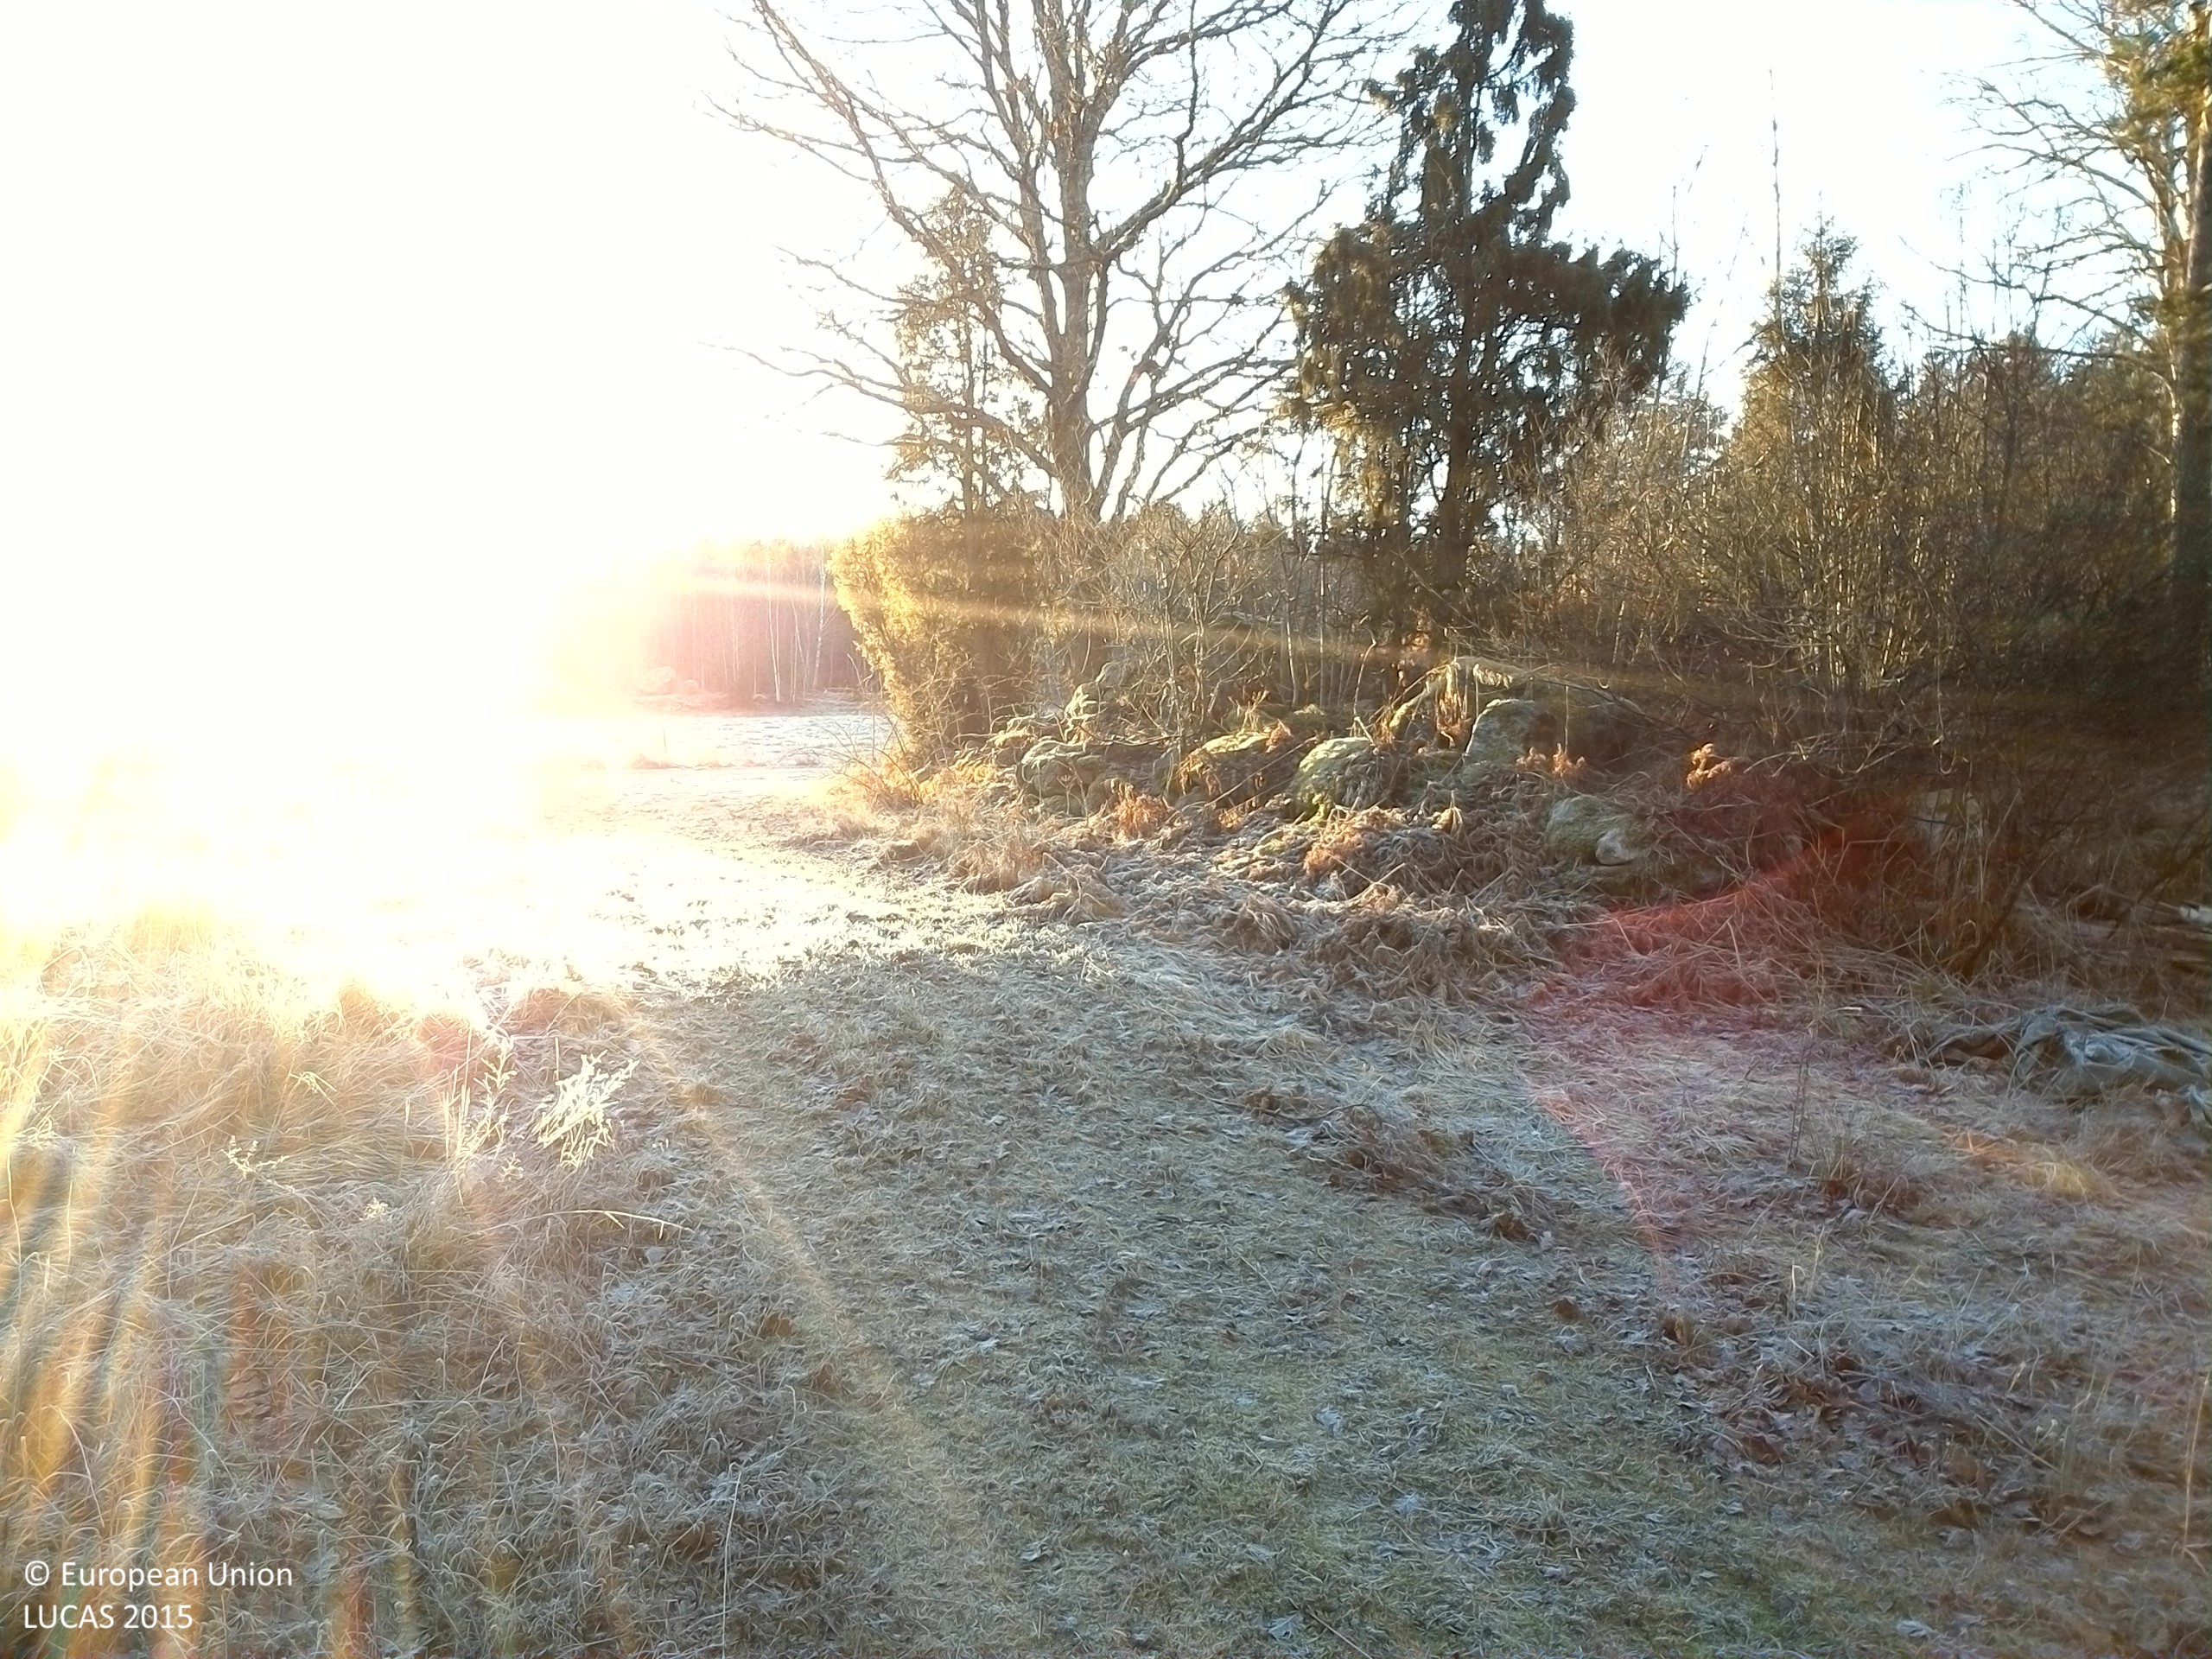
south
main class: Grassland
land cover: Grassland with sparse tree/shrub cover
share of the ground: > 75 %
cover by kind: herbaceous plants 95 %, coniferous forest trees 5 %
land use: Residential
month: December
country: SE
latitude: 59.3354
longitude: 16.3035
